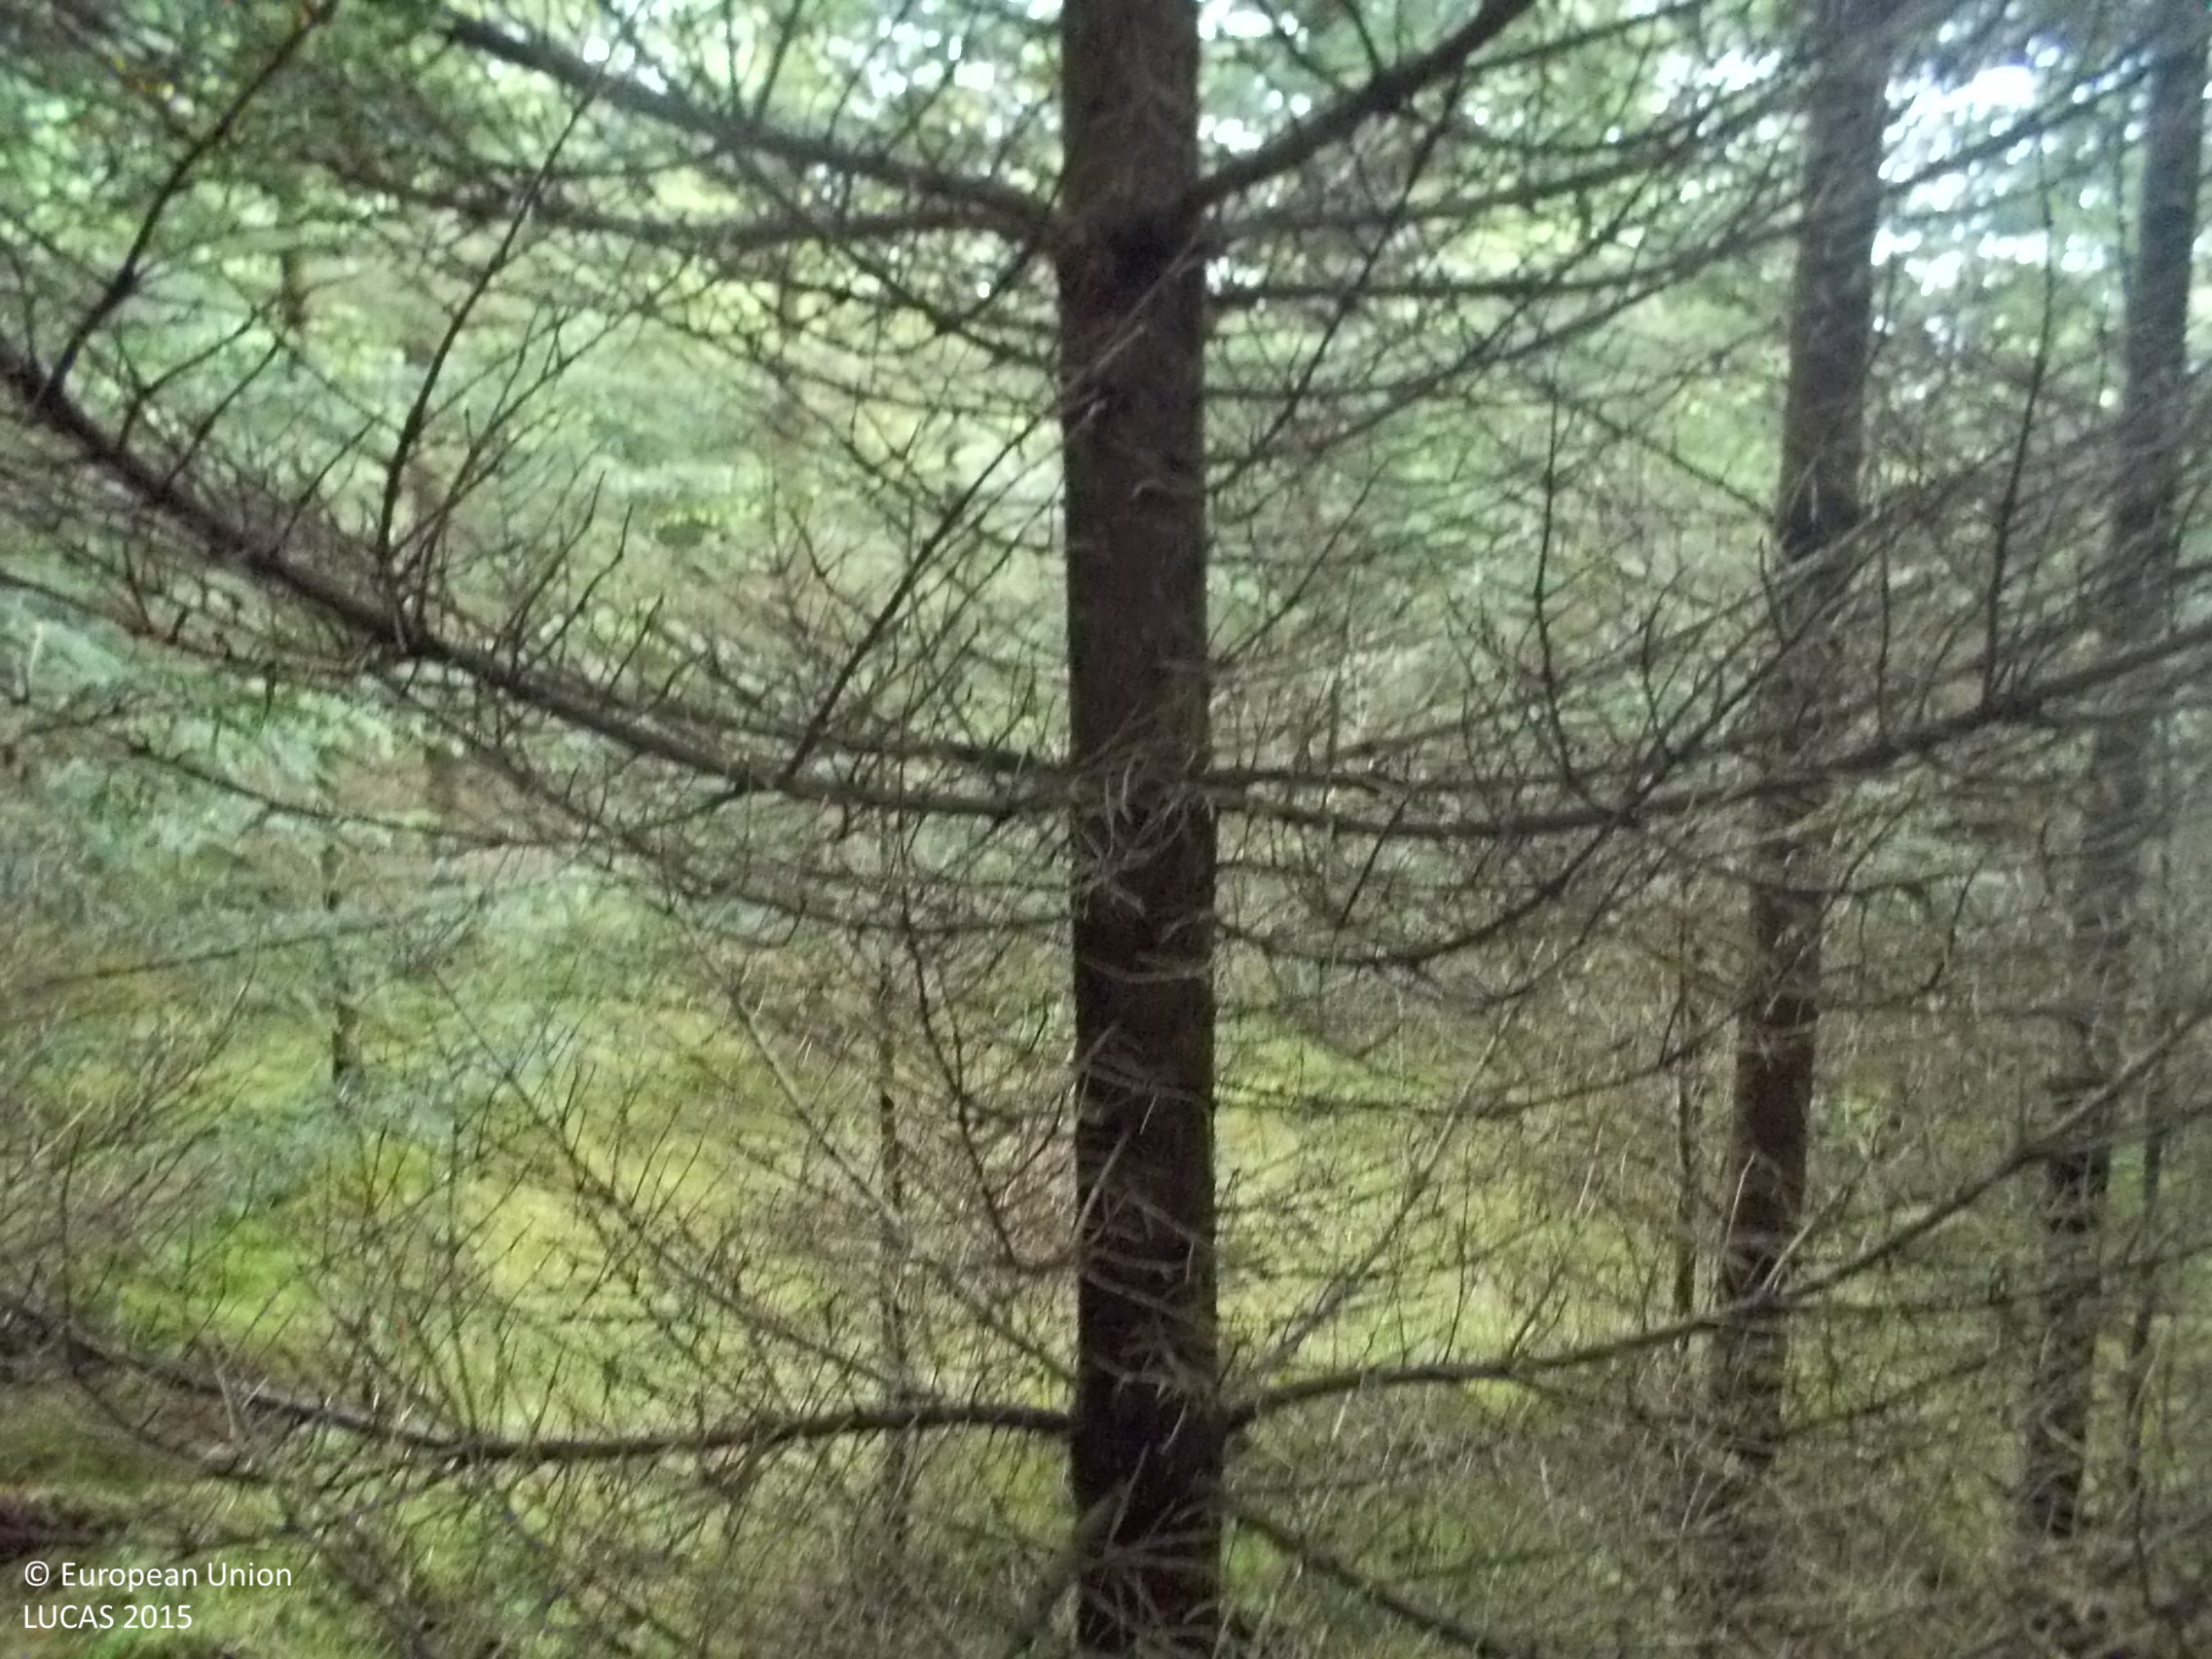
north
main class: Woodland
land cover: Spruce dominated coniferous woodland
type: boreal forest
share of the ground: > 75 %
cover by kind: coniferous forest trees 95 %, lichens and mosses 5 %
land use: Forestry
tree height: > 5 m
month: June
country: SE
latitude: 57.0198
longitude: 12.8461
